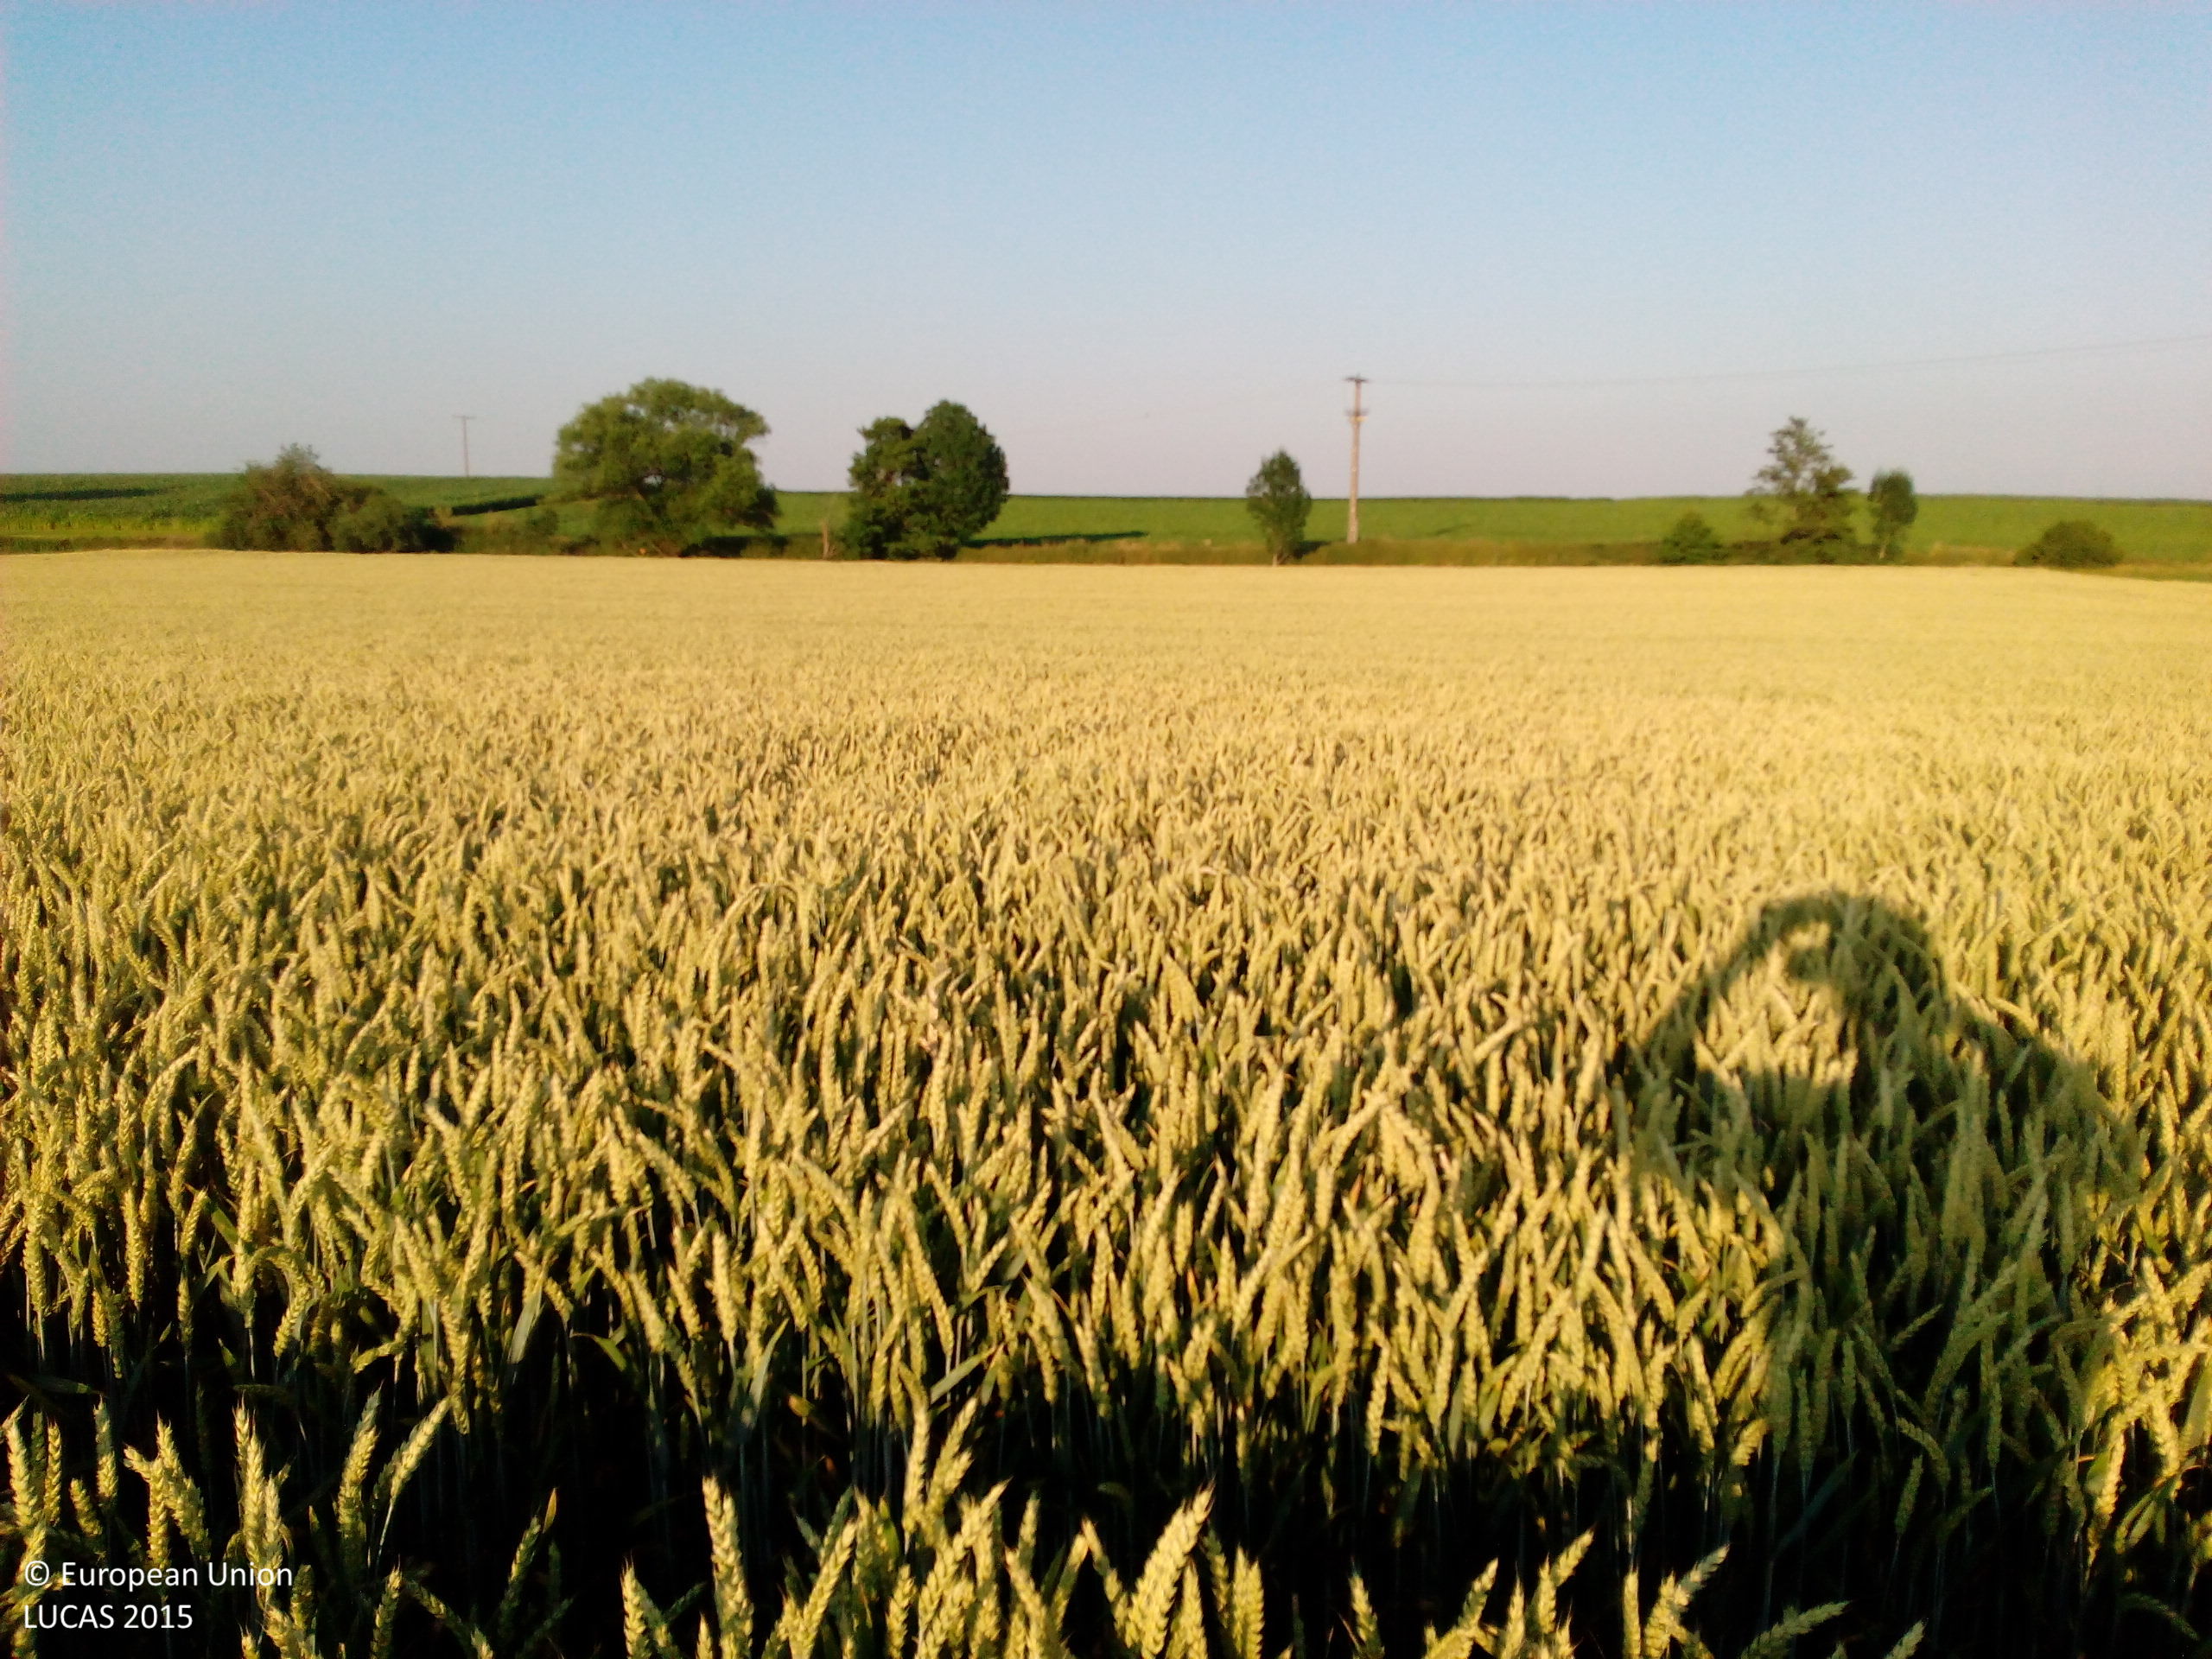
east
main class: Cropland
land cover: Common wheat
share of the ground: > 75 %
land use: Agriculture (excluding fallow land and kitchen gardens)
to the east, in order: Common wheat; Temporary grasslands; Shruby margins; Ditches and canals; Grassland with sparse tree/shrub cover; Temporary grasslands; Sugar beet; Electric lines; Sugar beet
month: July
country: DE
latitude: 48.6703
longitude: 12.9461
